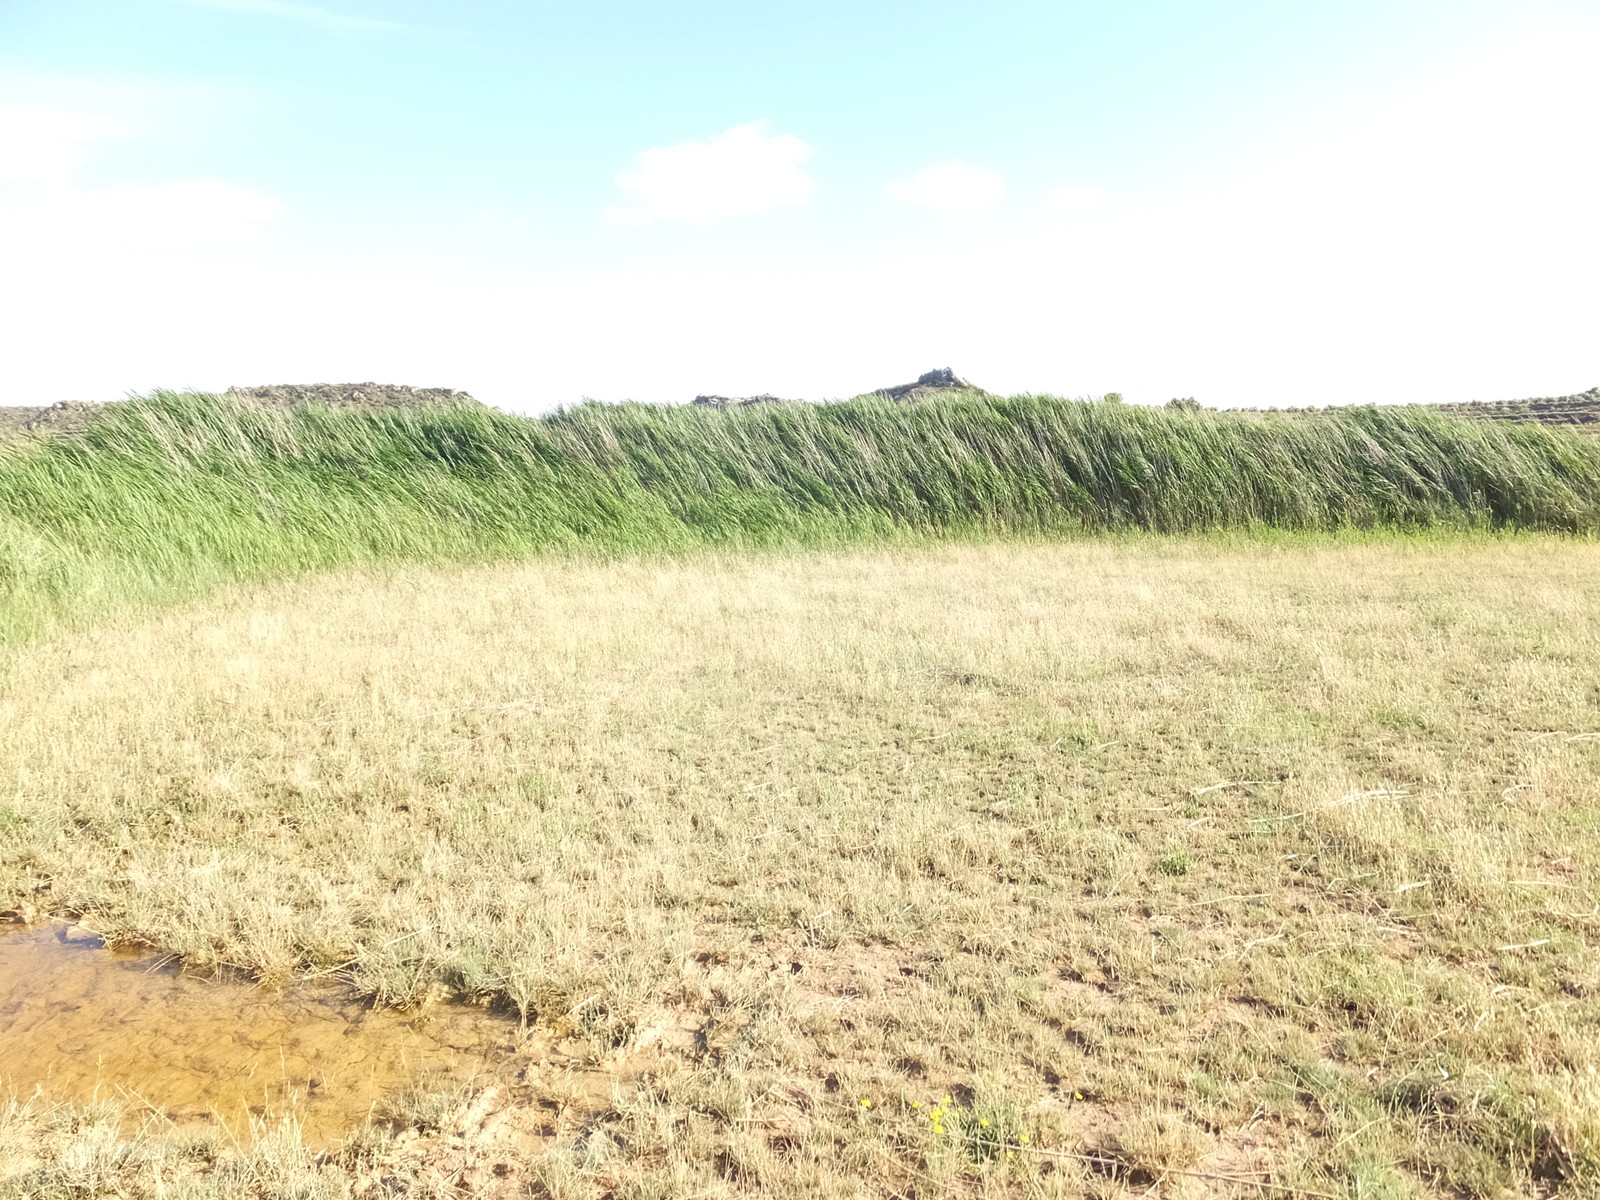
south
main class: Cropland
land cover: Lucerne
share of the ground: > 75 %
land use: Agriculture (excluding fallow land and kitchen gardens)
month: June
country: ES
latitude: 41.2136
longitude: -0.1630
